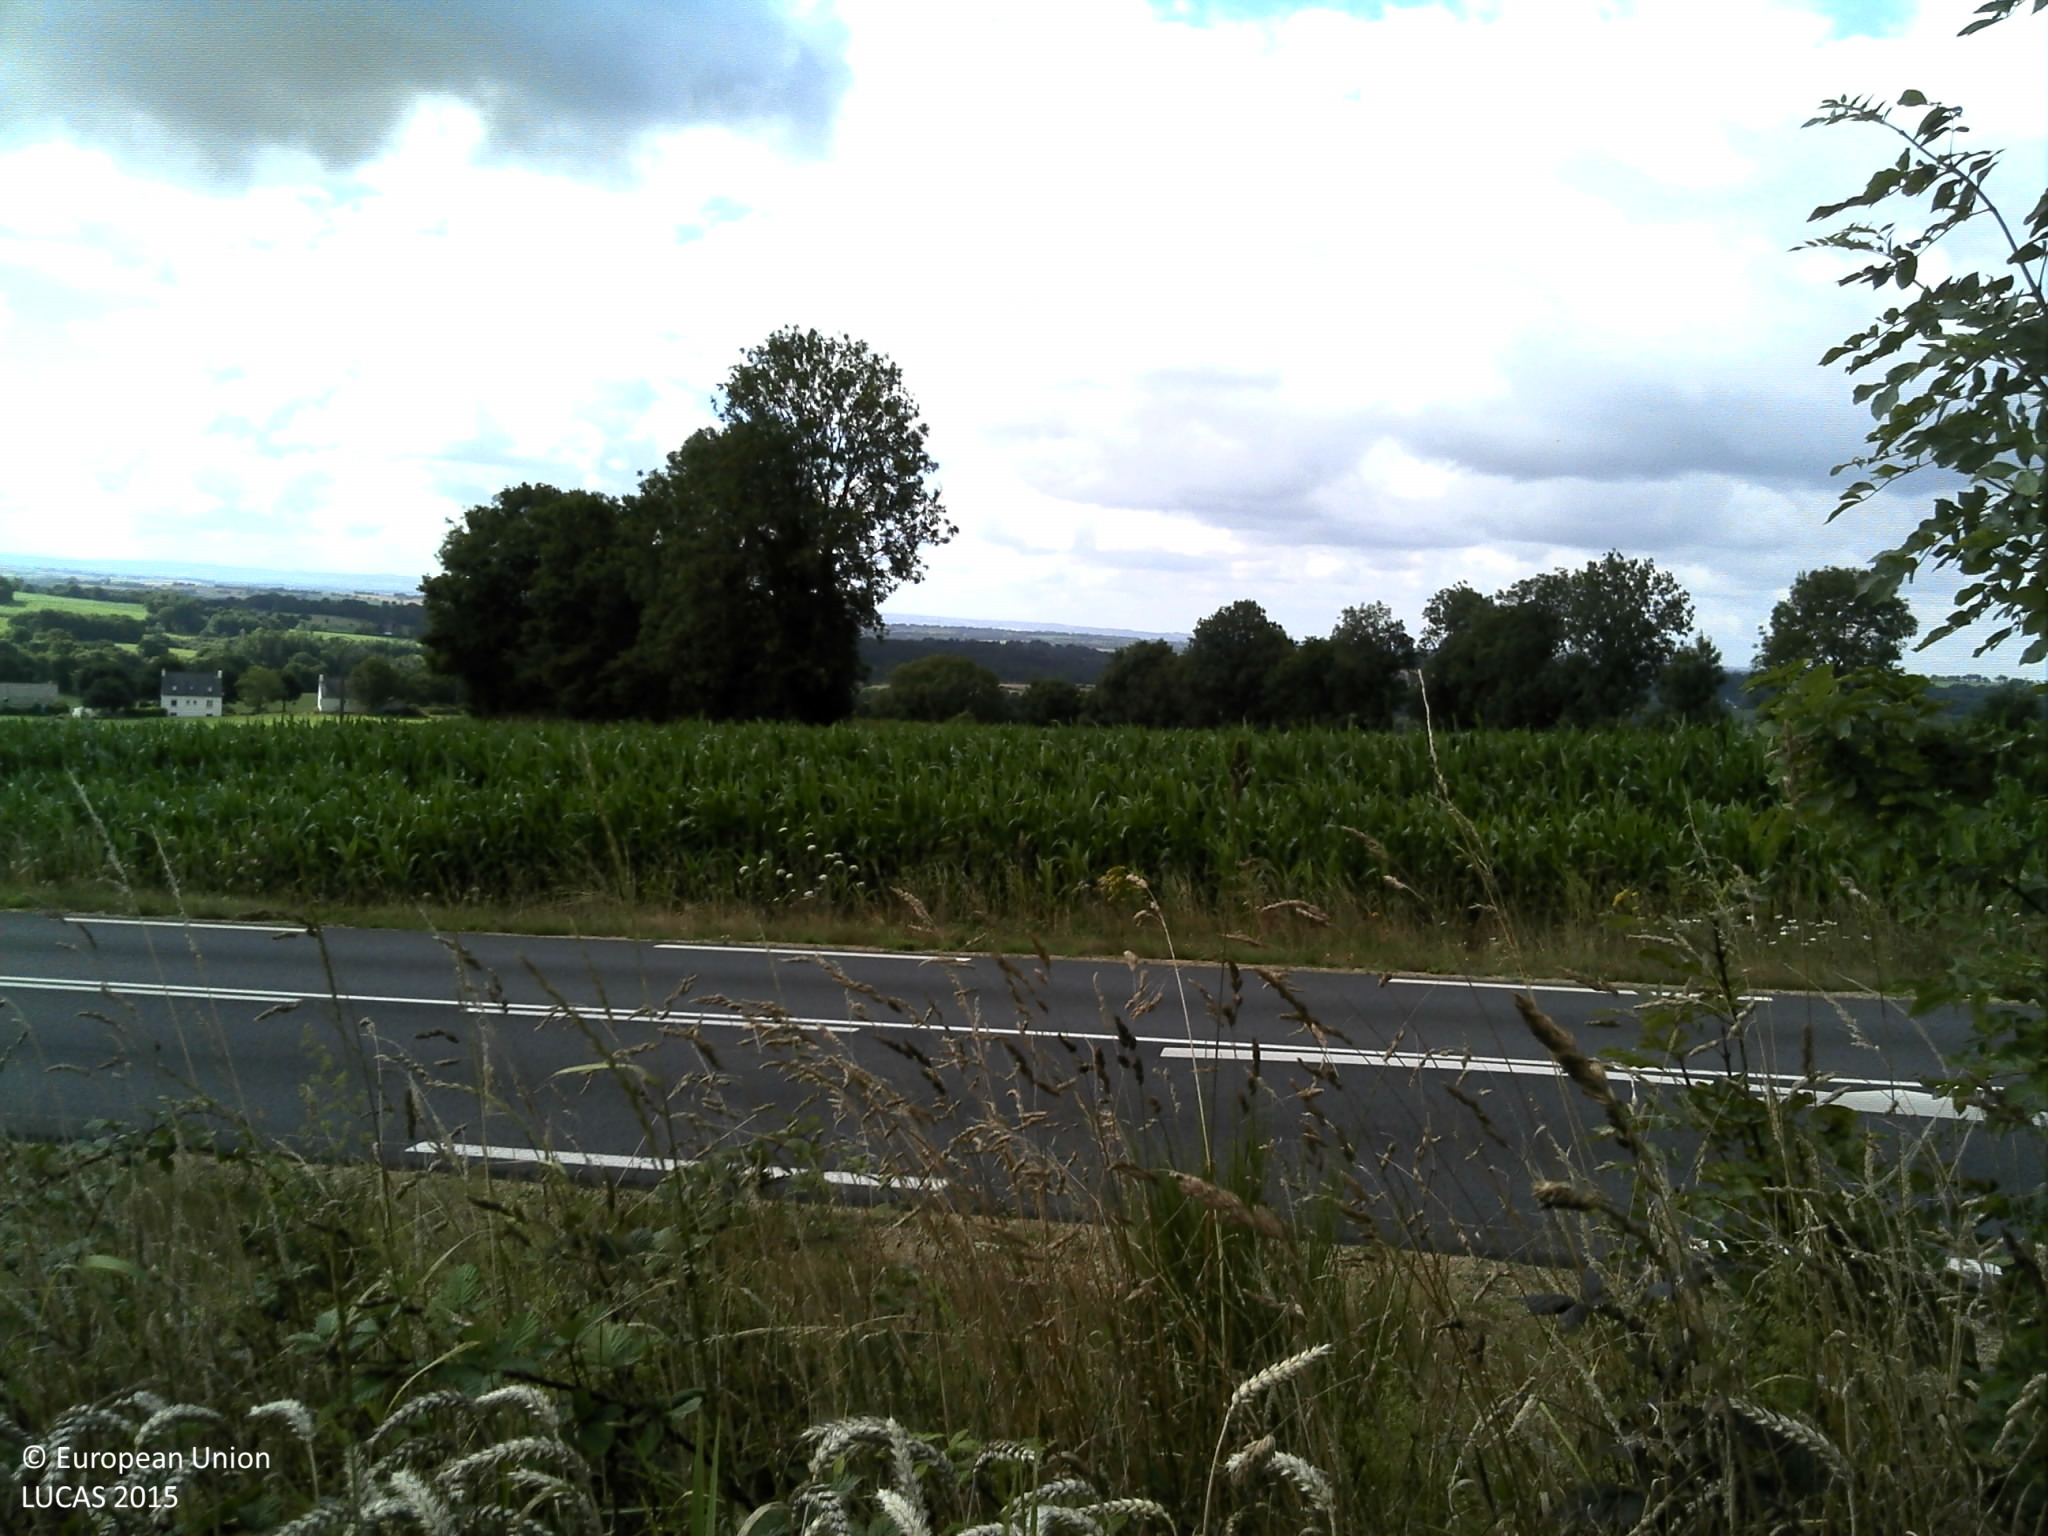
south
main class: Cropland
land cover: Common wheat
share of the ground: > 75 %
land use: Agriculture (excluding fallow land and kitchen gardens)
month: July
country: FR
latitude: 48.3456
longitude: -3.7238
